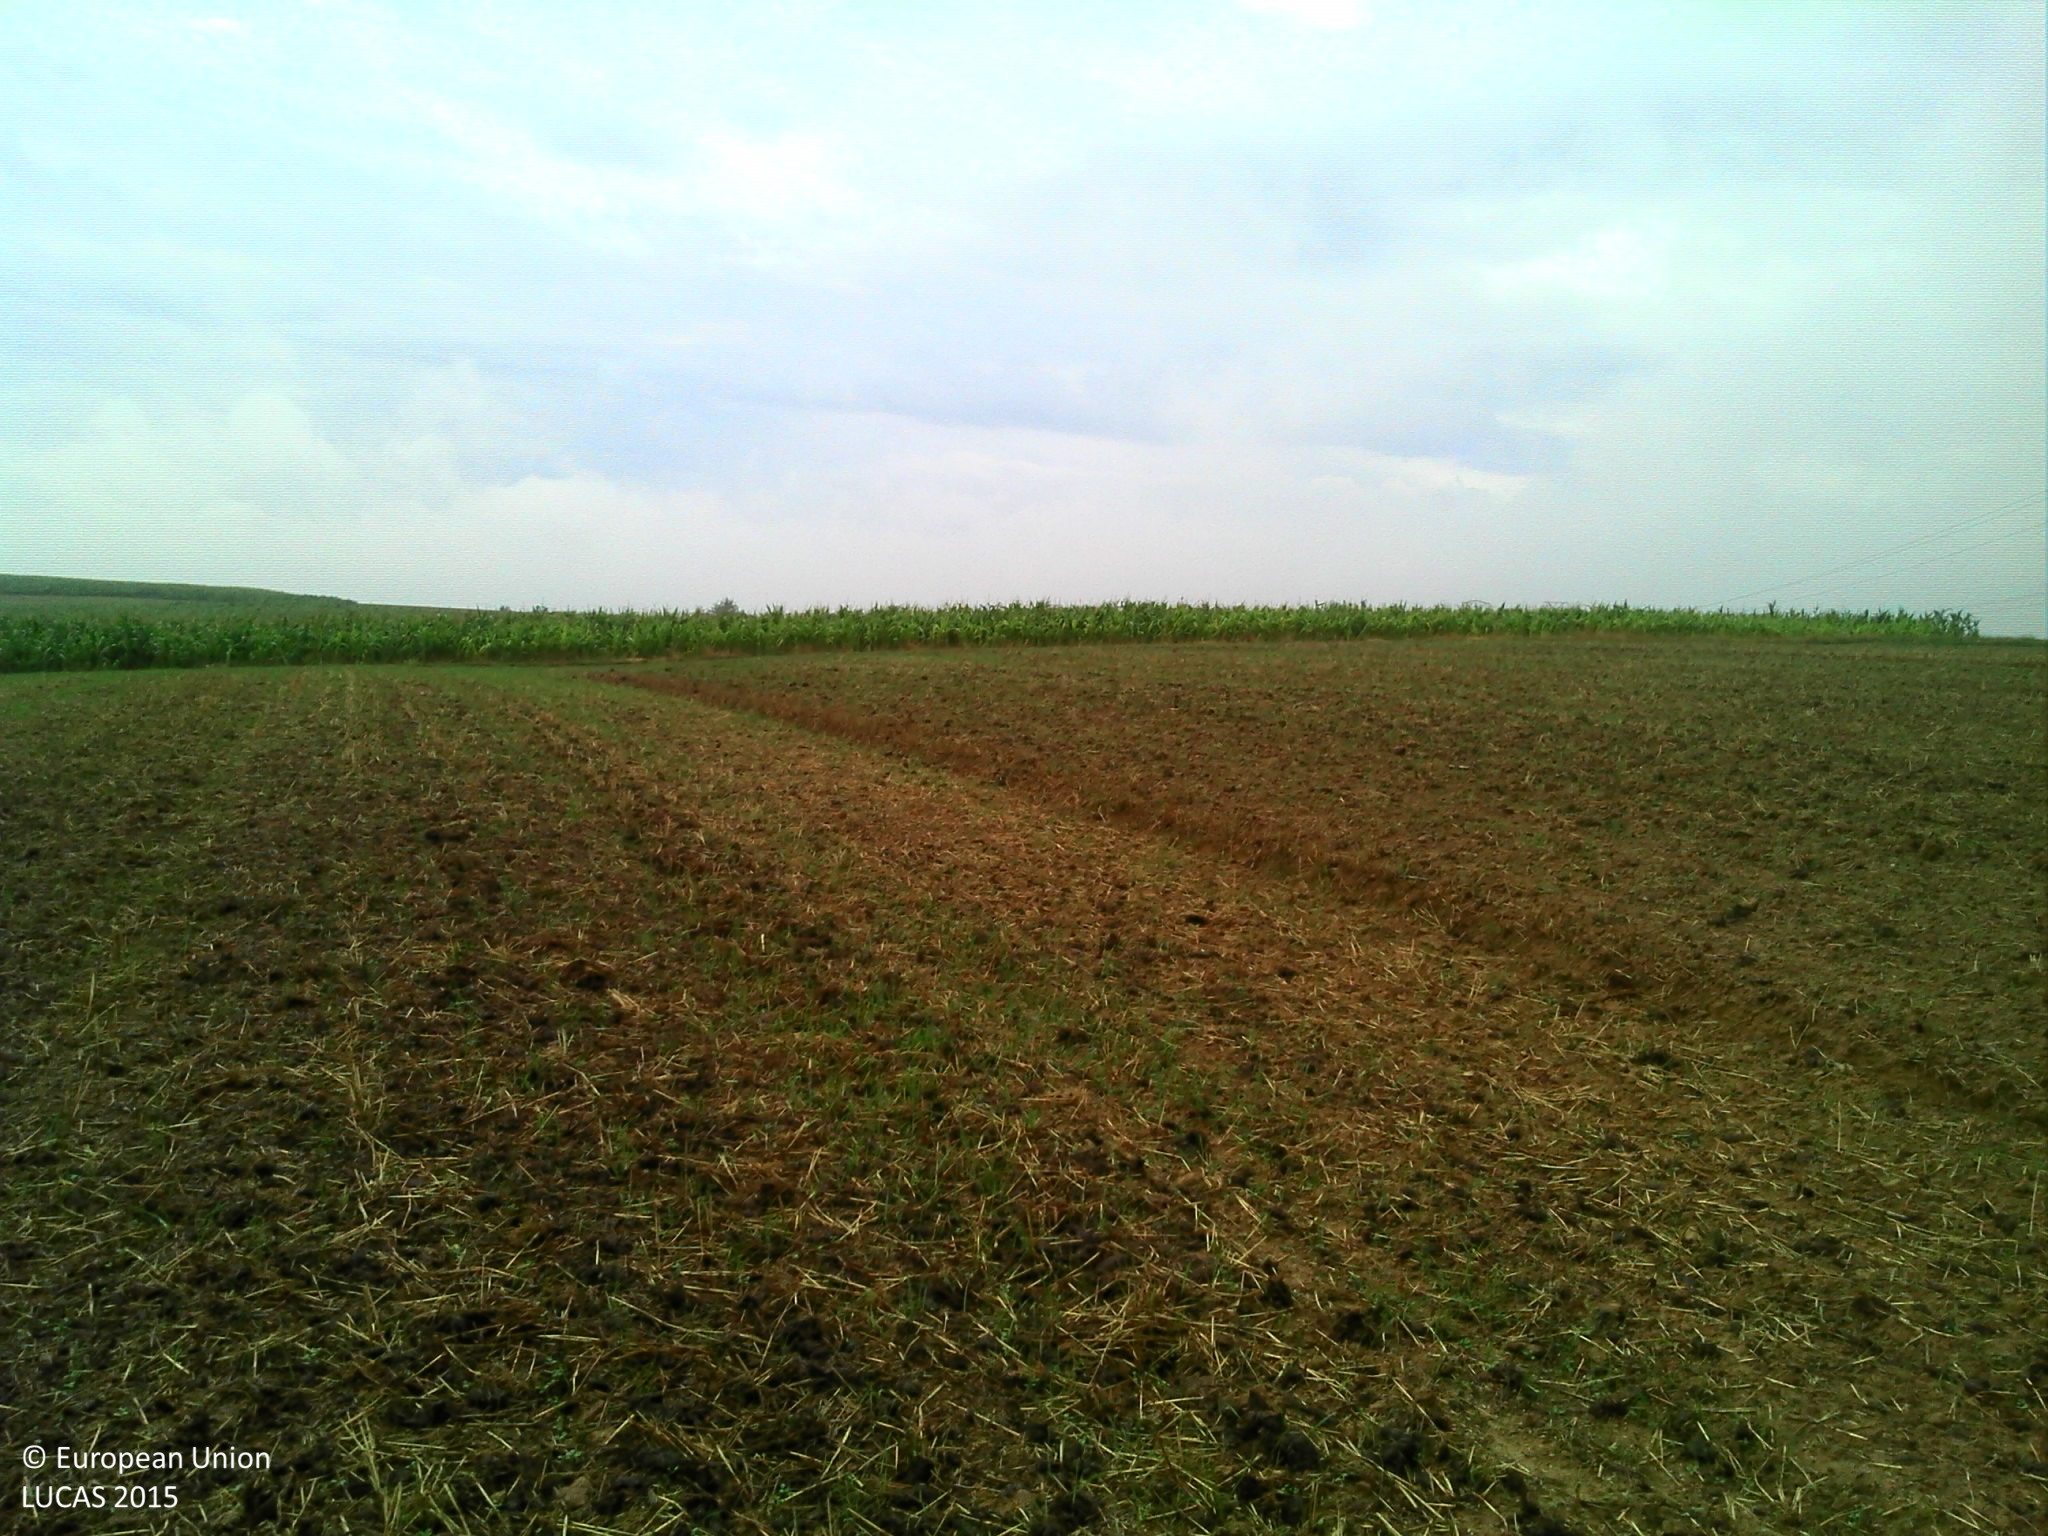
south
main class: Cropland
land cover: Common wheat
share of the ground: 10 - 25 %
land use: Agriculture (excluding fallow land and kitchen gardens)
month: August
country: FR
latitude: 48.8434
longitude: 7.5071
